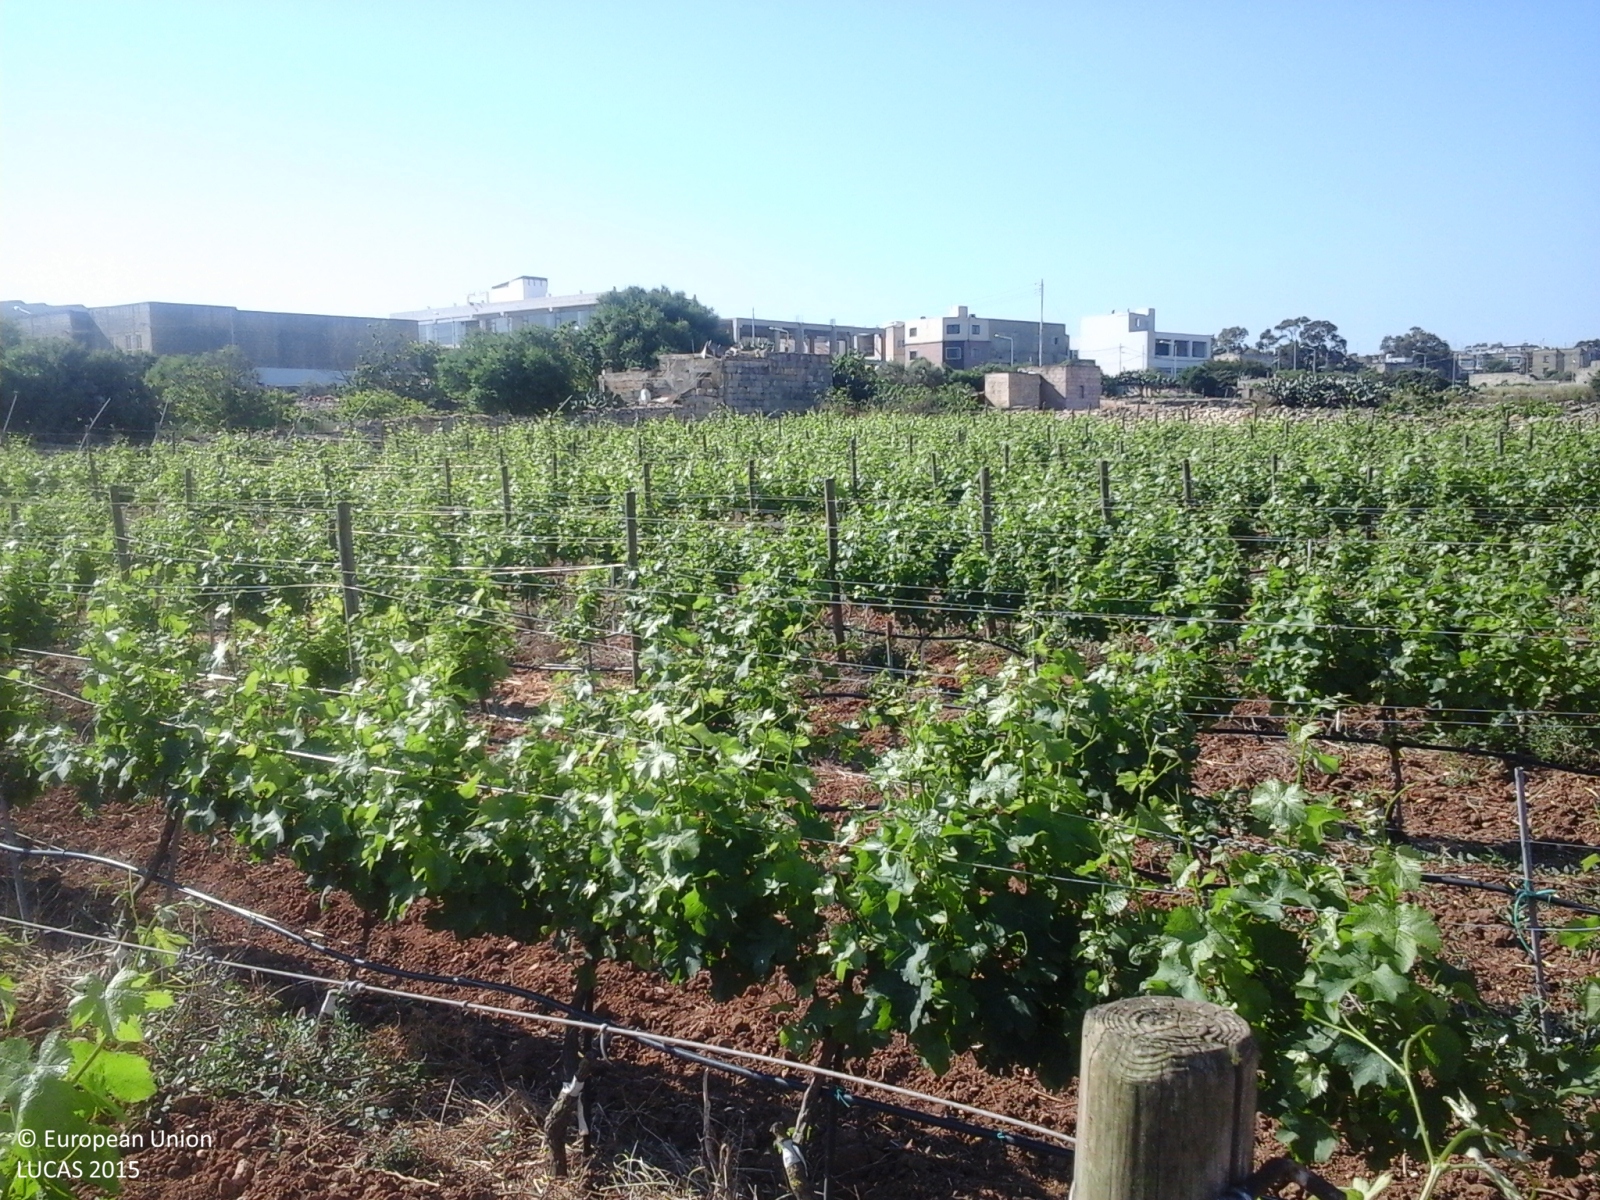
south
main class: Cropland
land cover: Vineyards
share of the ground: 25 - 50 %
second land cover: Other bare soil
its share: > 75 %
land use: Agriculture (excluding fallow land and kitchen gardens)
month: May
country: MT
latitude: 35.8571
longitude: 14.5094
